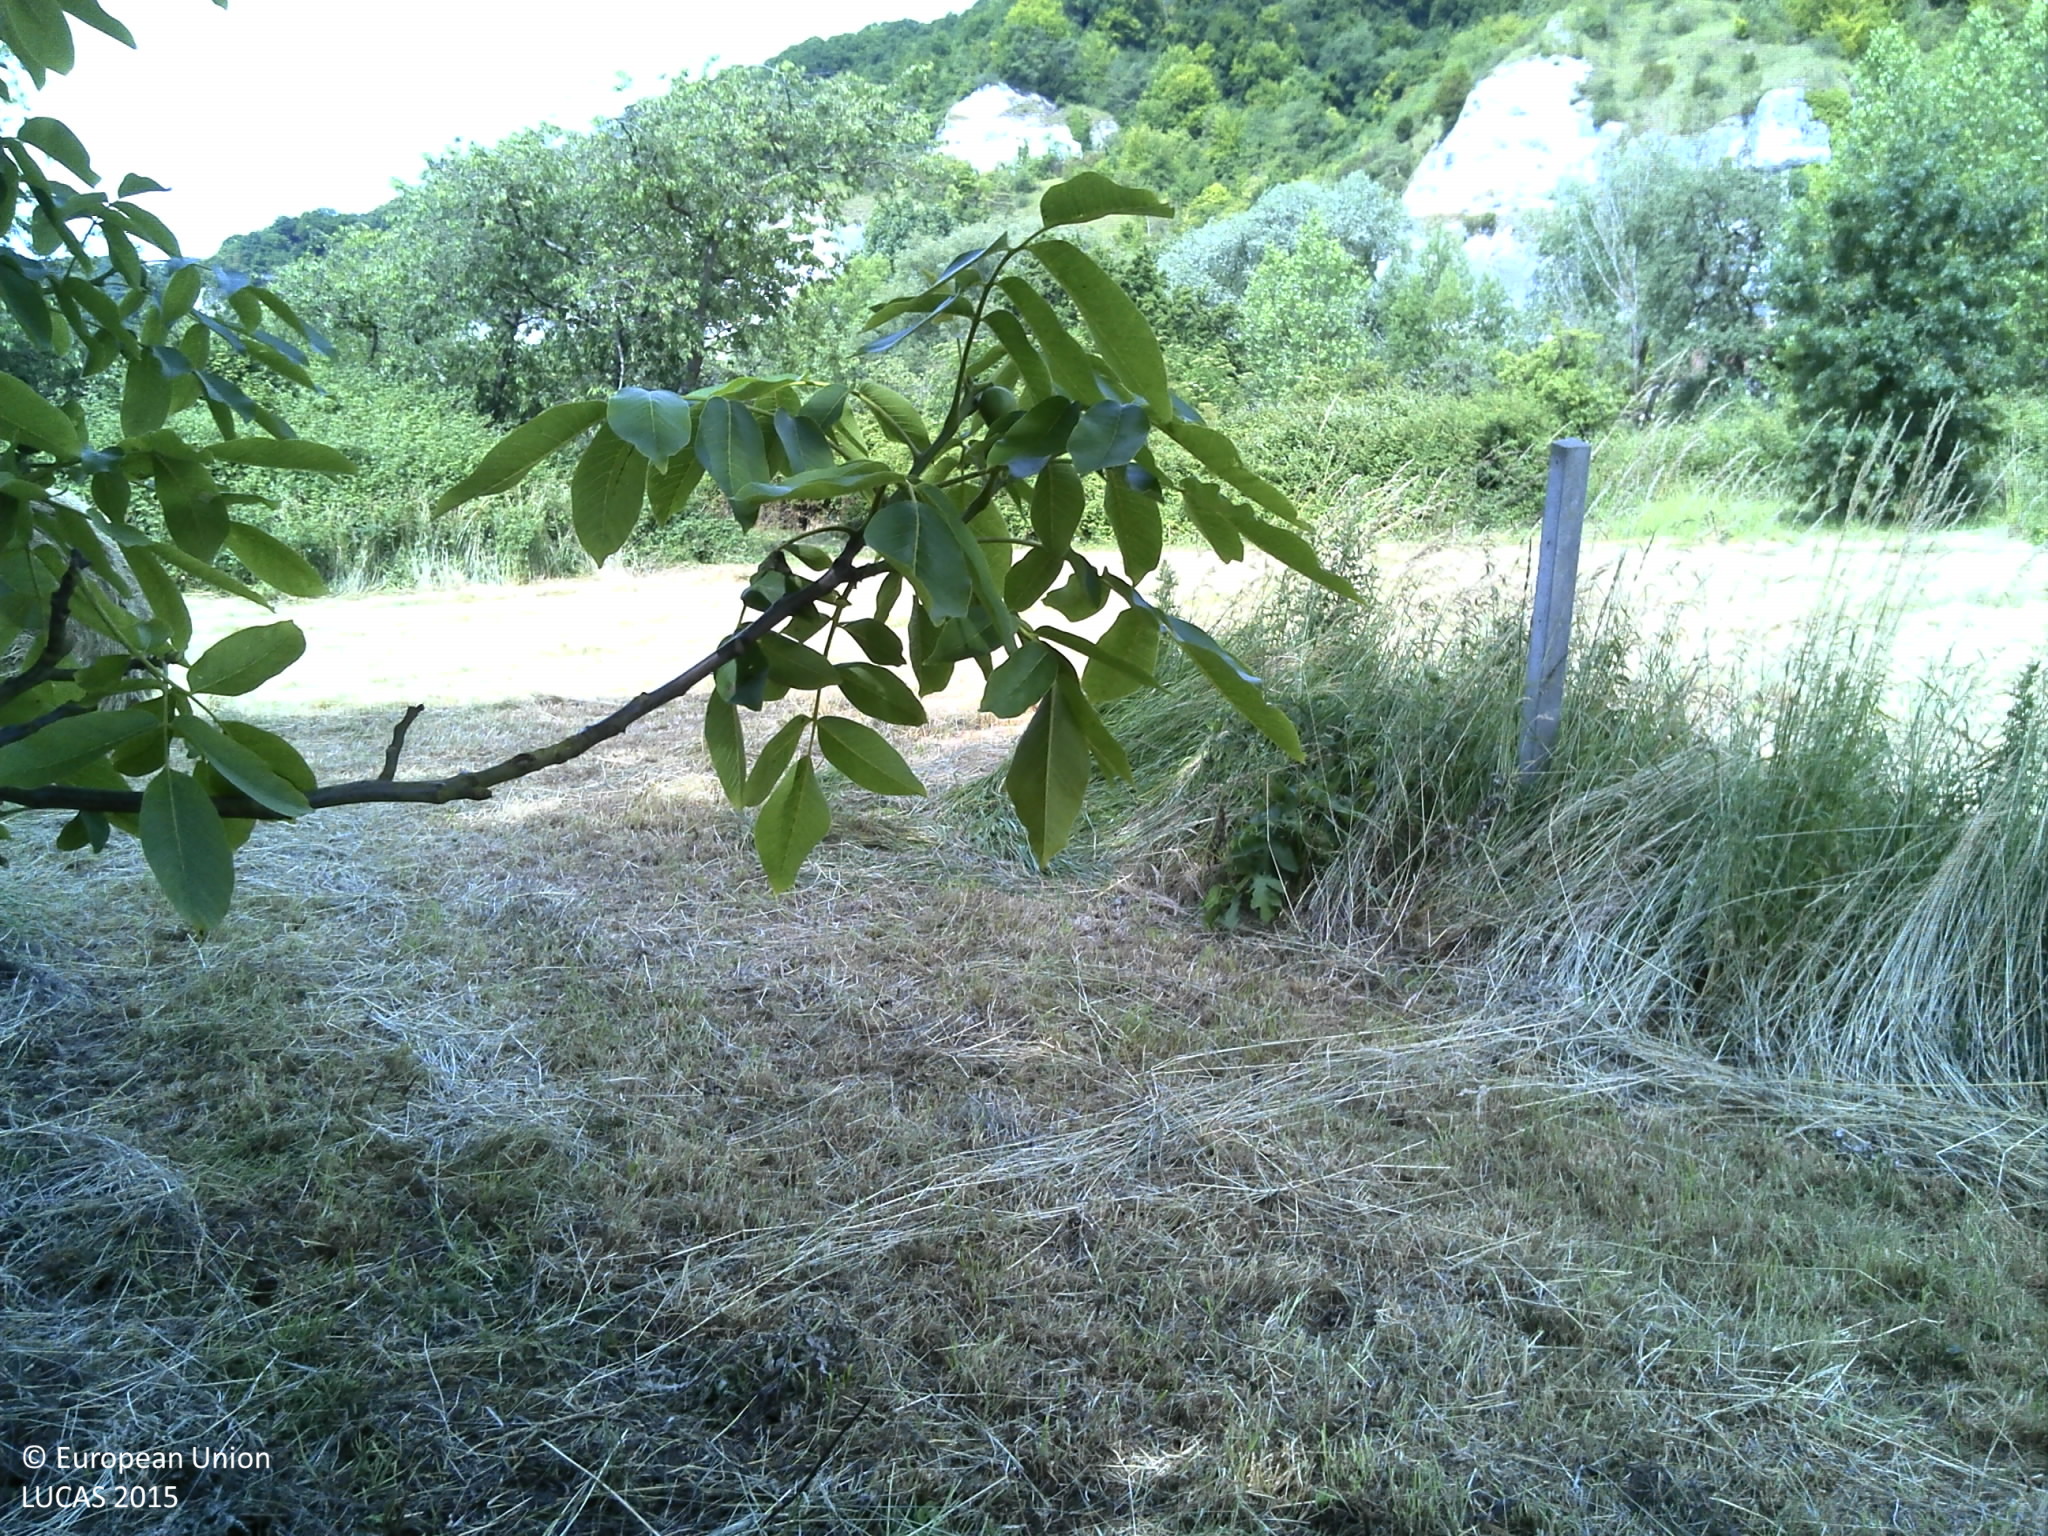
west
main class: Cropland
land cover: Nuts trees
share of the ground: 50 - 75 %
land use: Agriculture (excluding fallow land and kitchen gardens)
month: June
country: FR
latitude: 49.3227
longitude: 1.0215
